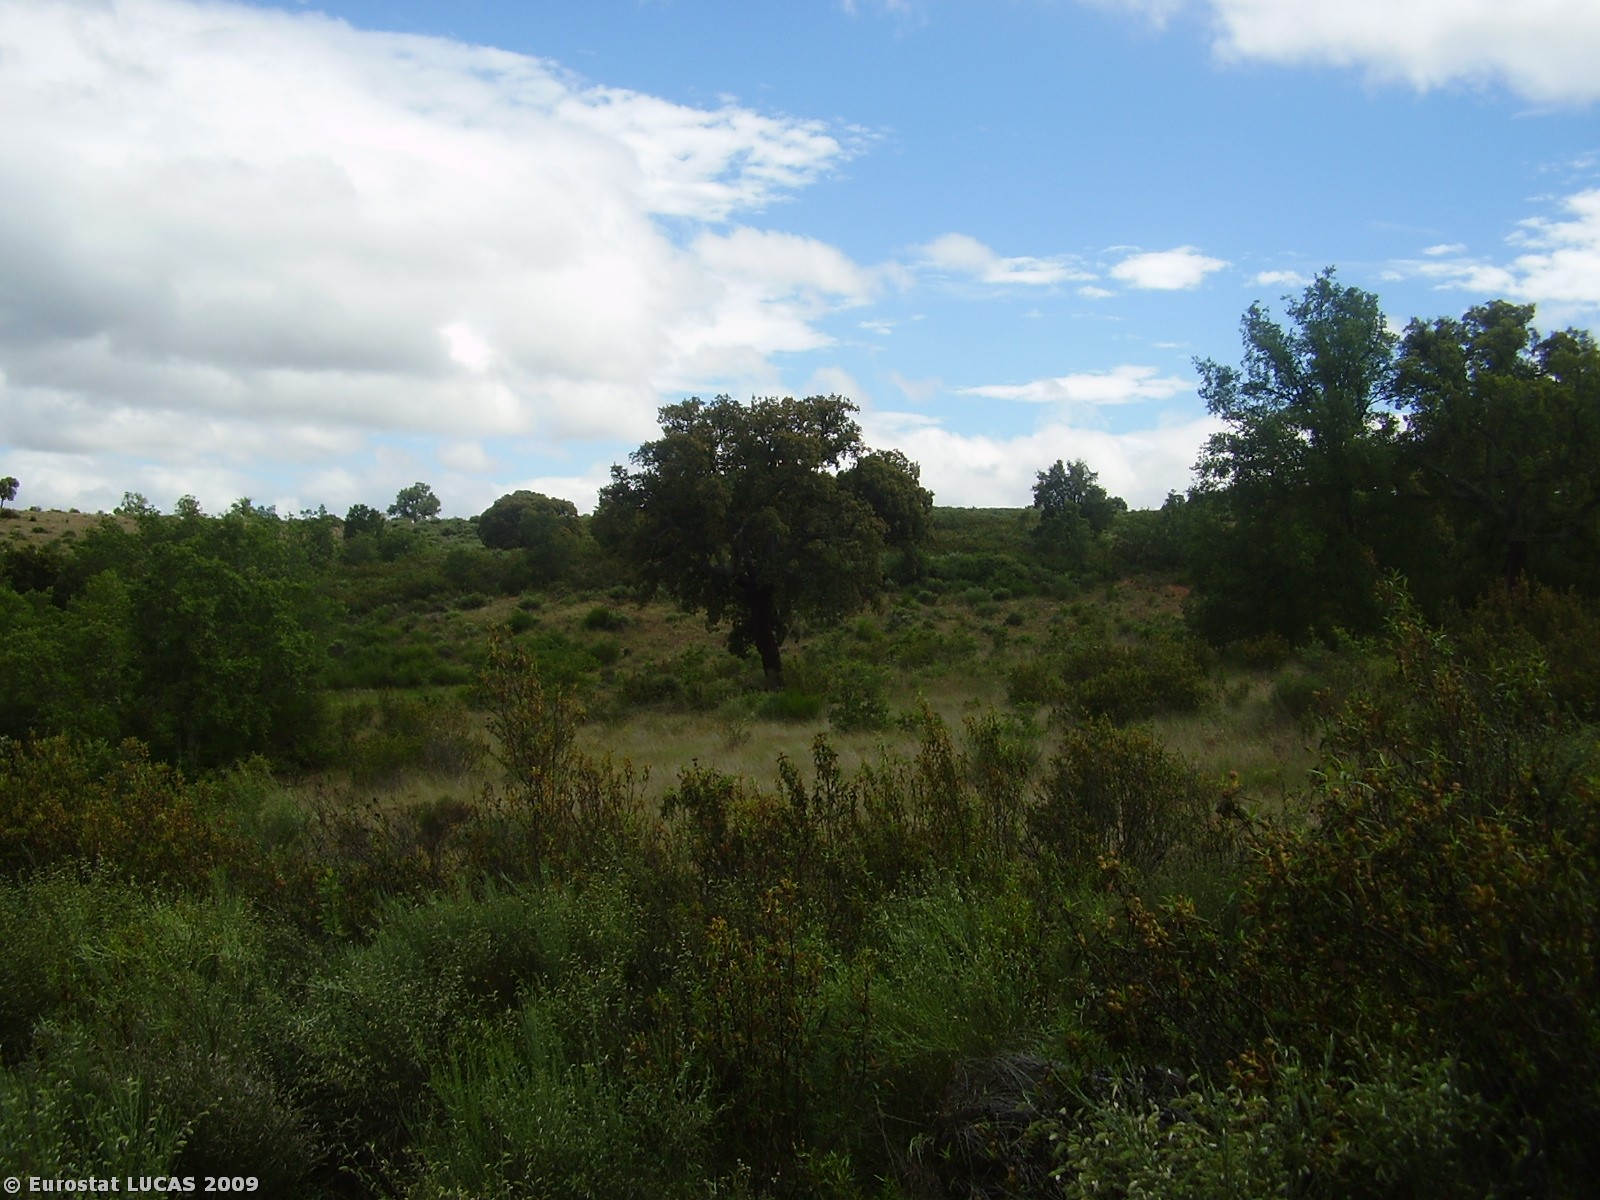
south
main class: Shrubland
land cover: Shrubland with sparse tree cover
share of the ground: > 75 %
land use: Nature reserves
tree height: > 5 m
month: June
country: PT
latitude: 41.5460
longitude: -6.8344
